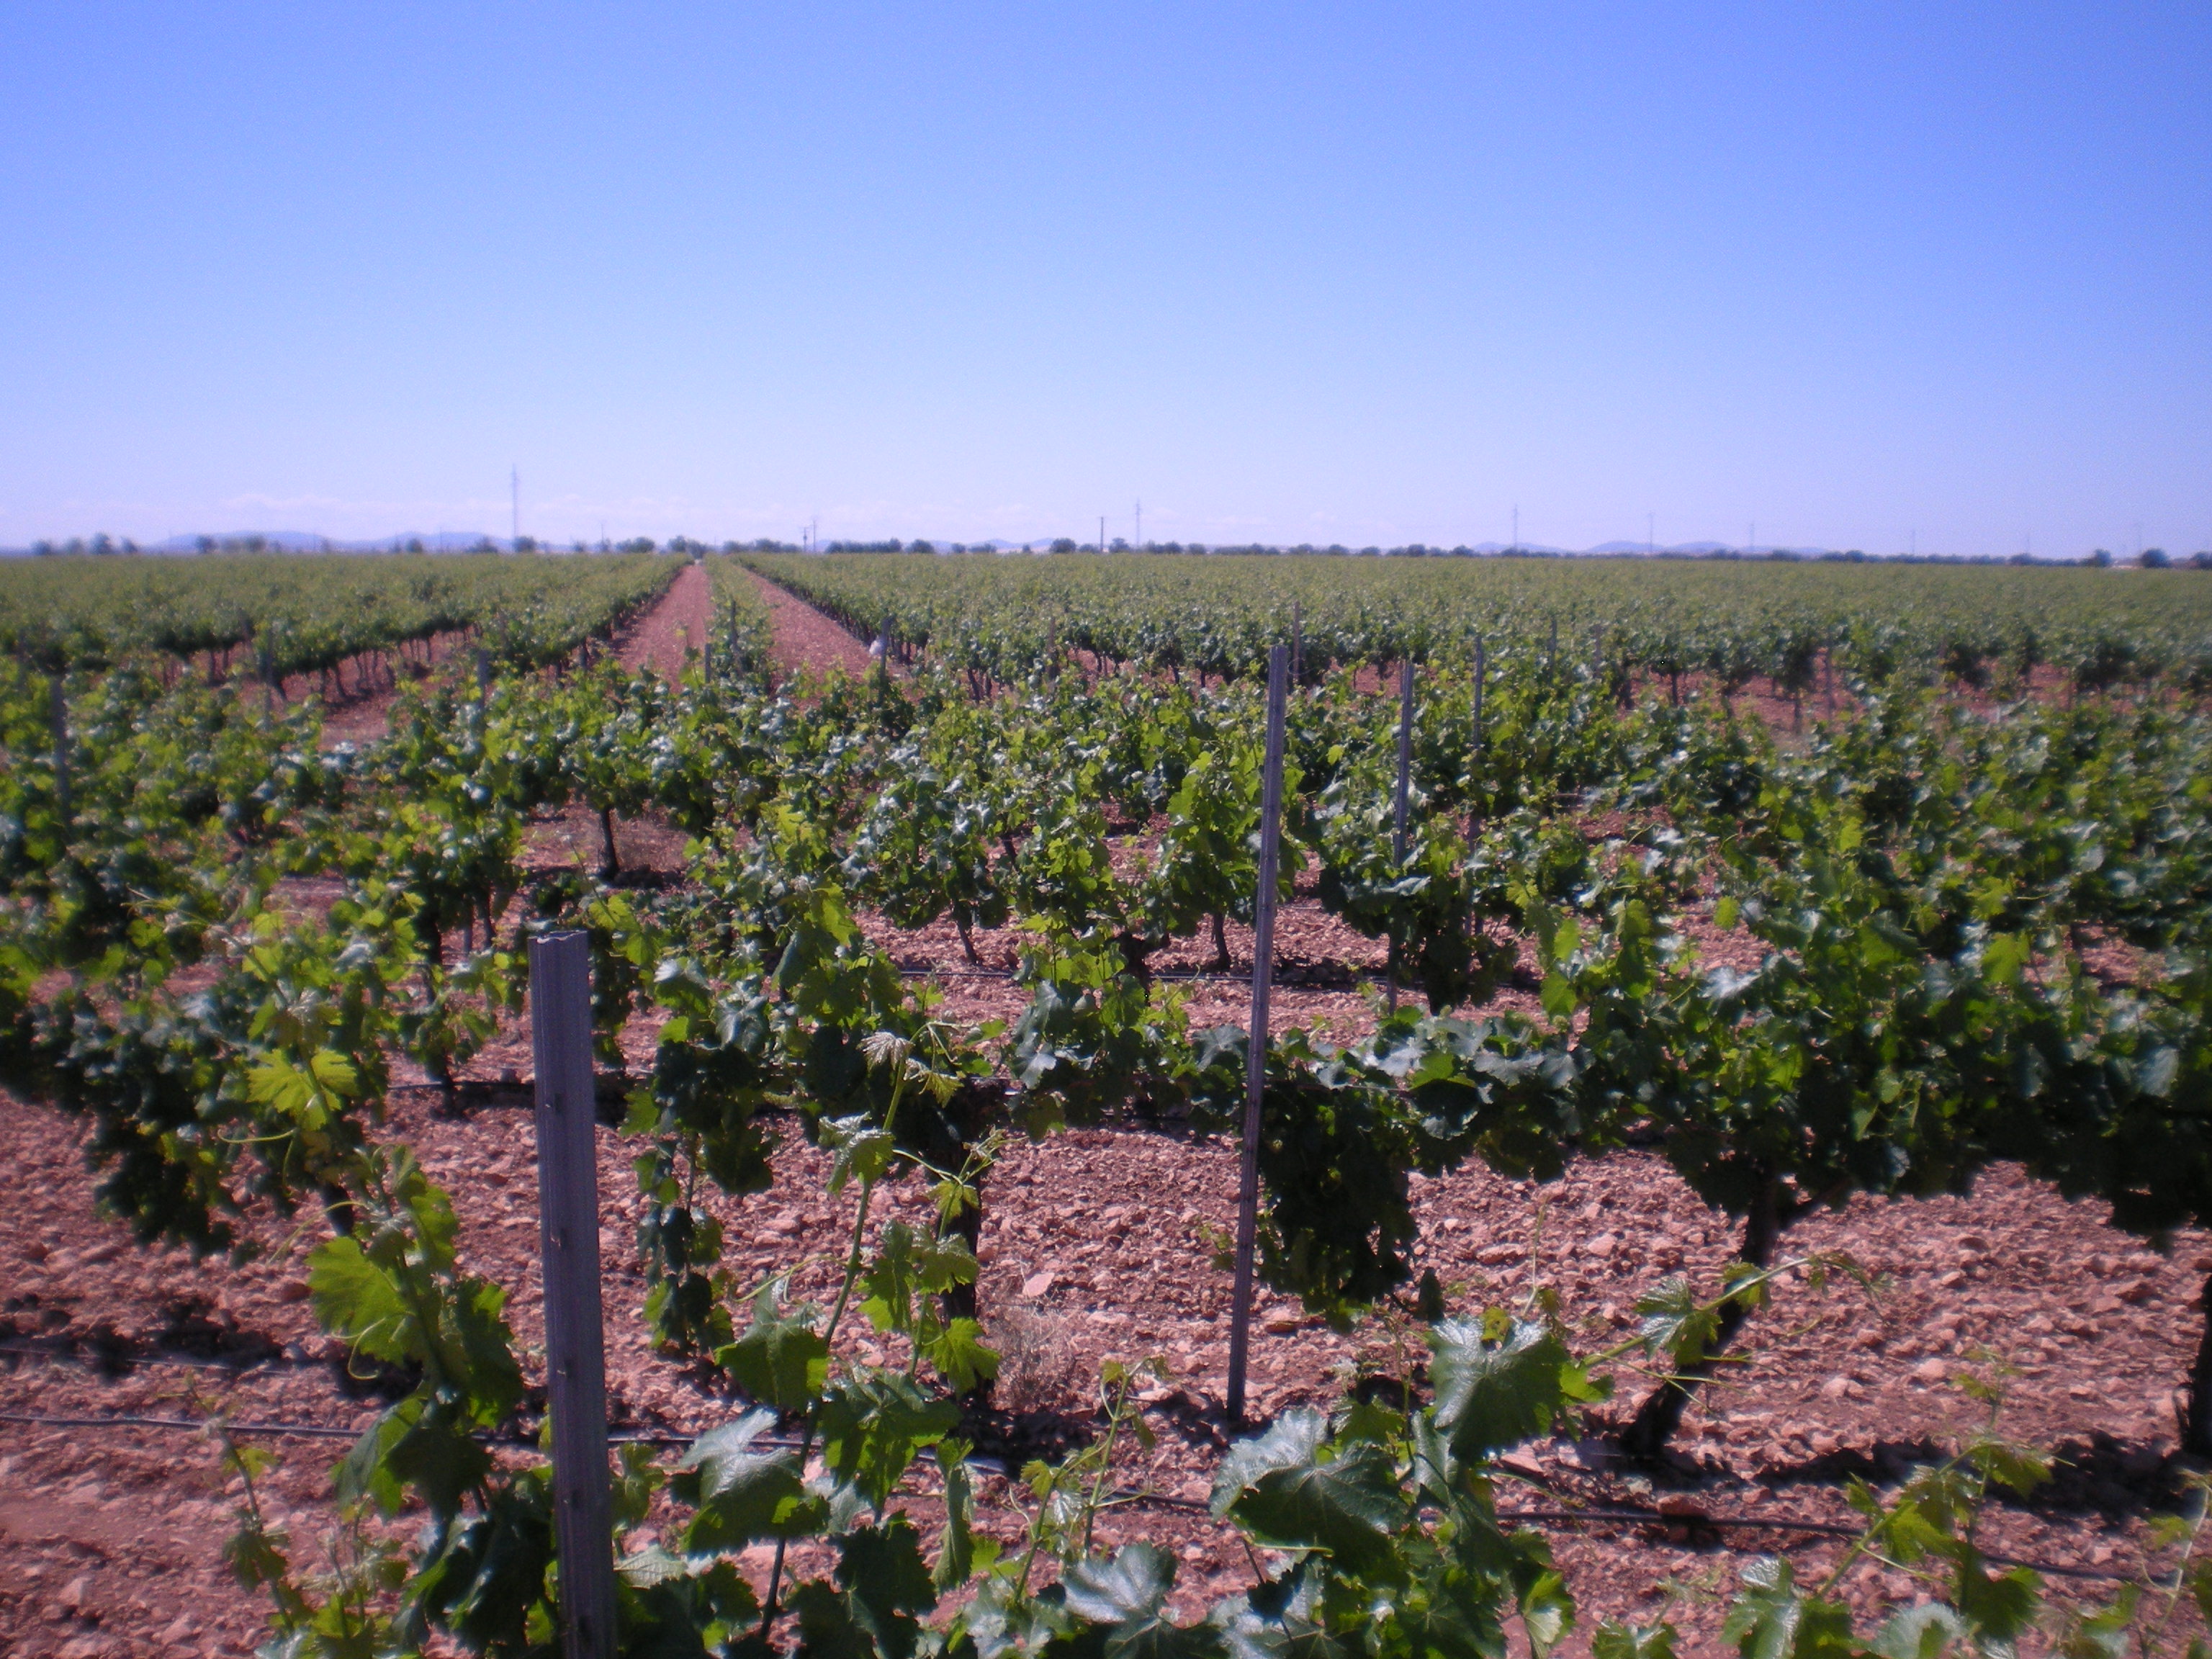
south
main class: Cropland
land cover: Vineyards
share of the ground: 10 - 25 %
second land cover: Other bare soil
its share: > 75 %
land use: Agriculture (excluding fallow land and kitchen gardens)
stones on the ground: 25 - 50 %
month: May
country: ES
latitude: 39.1428
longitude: -3.2627
